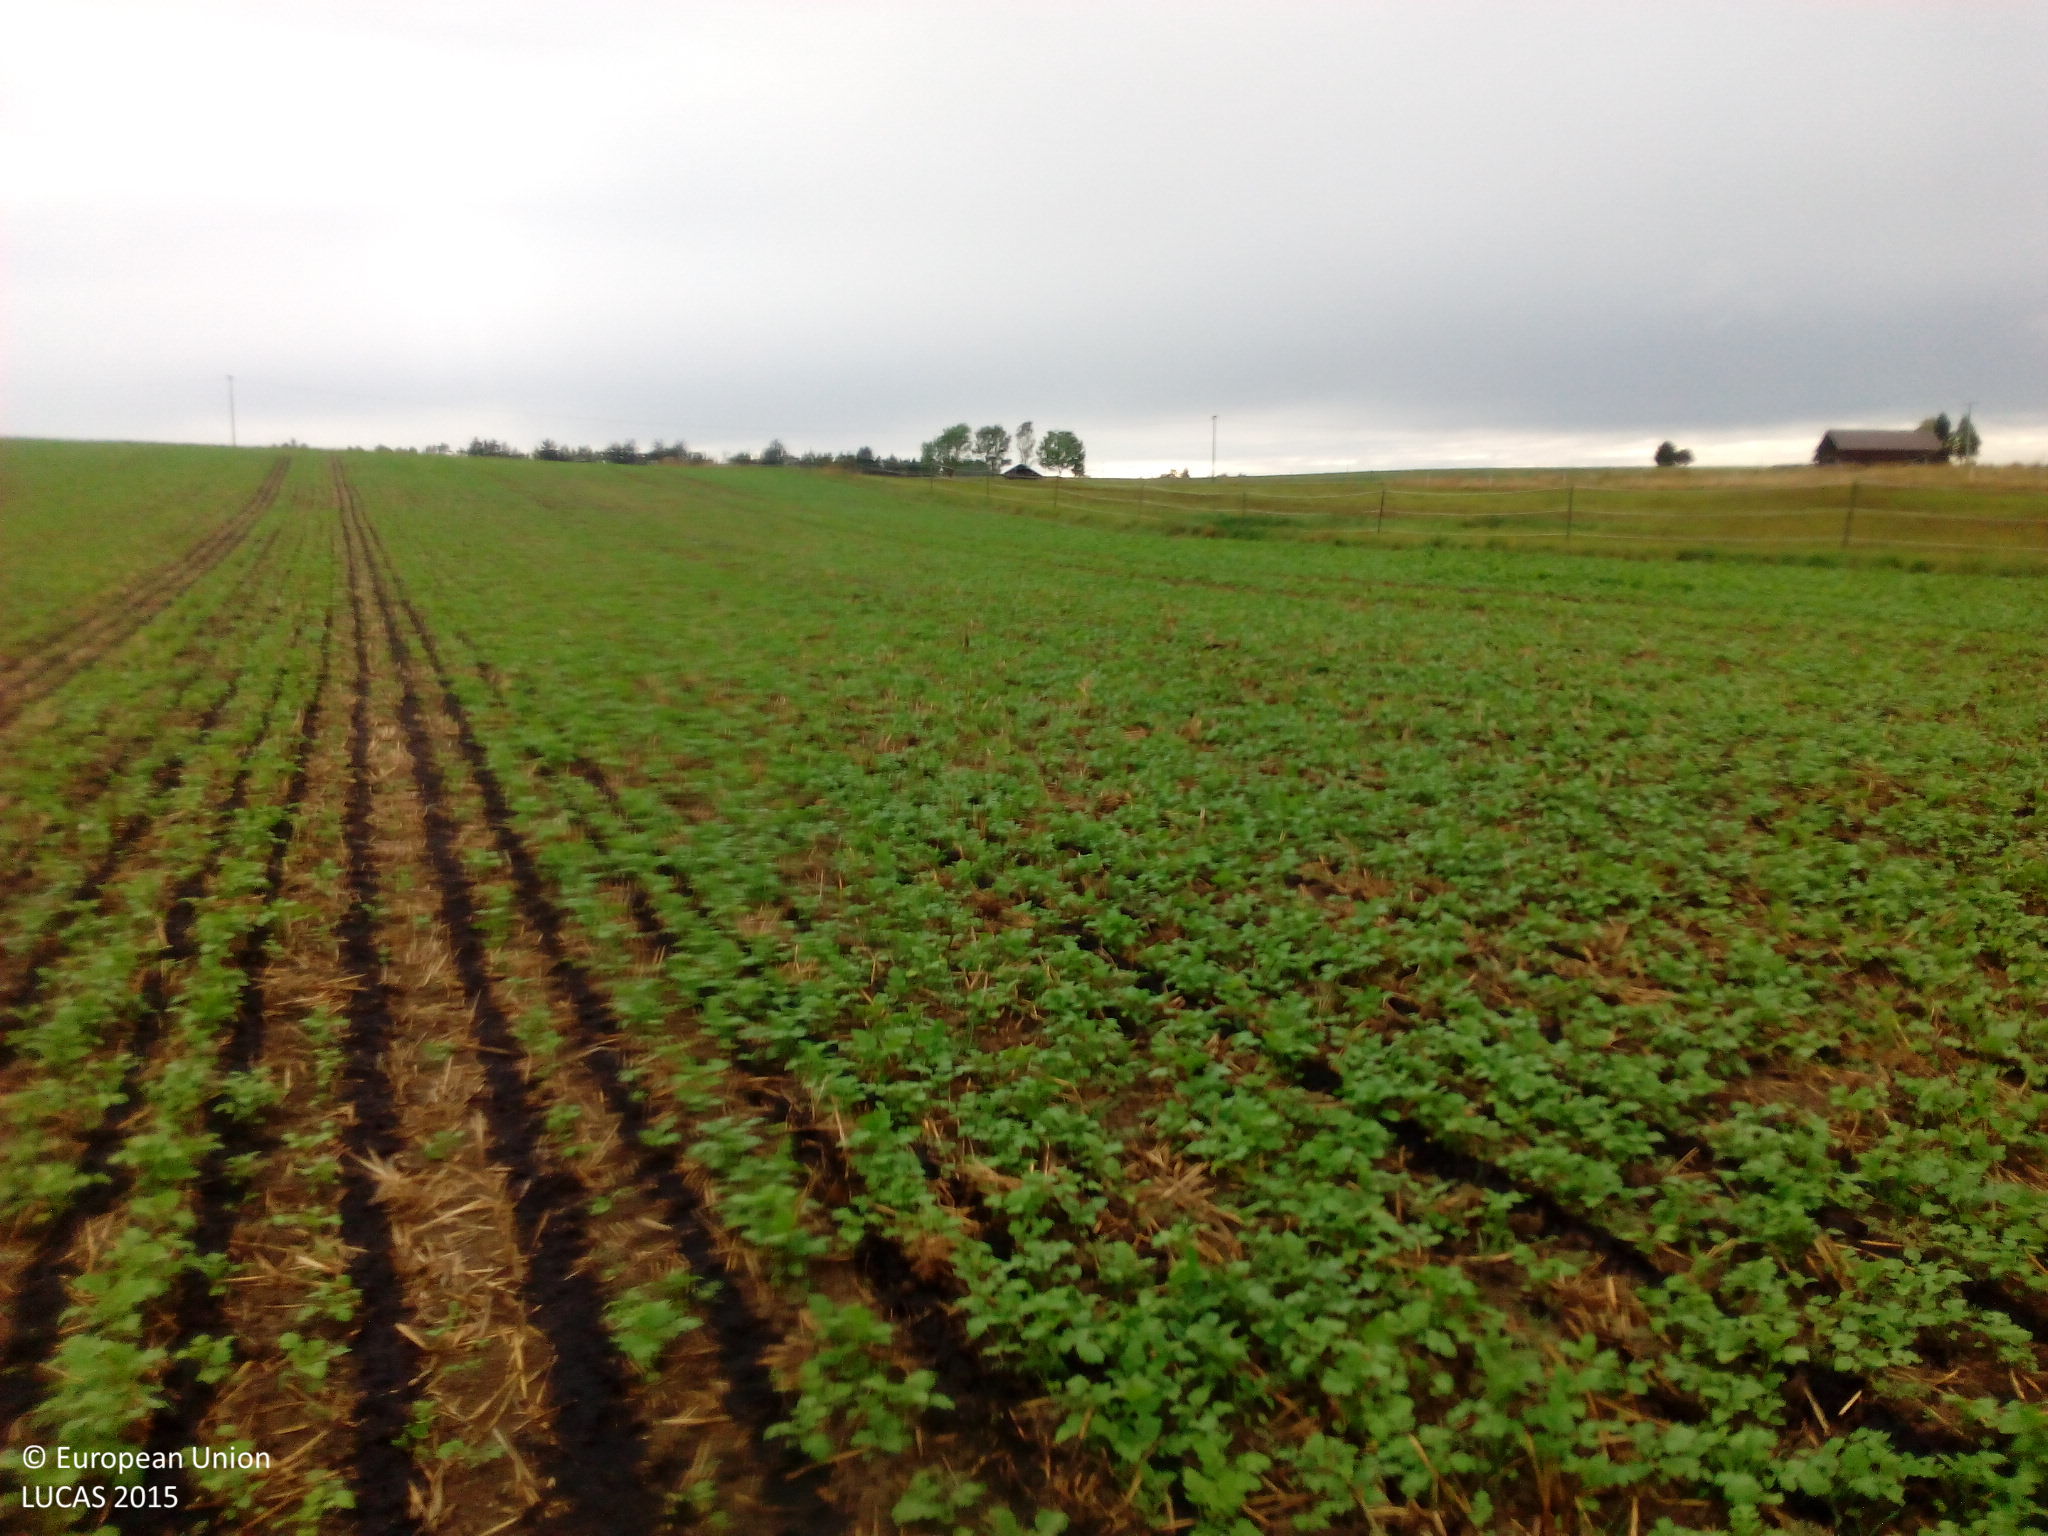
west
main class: Cropland
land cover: Other fibre and oleaginous crops
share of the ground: 50 - 75 %
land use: Agriculture (excluding fallow land and kitchen gardens)
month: September
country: DE
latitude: 48.1425
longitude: 8.5897
